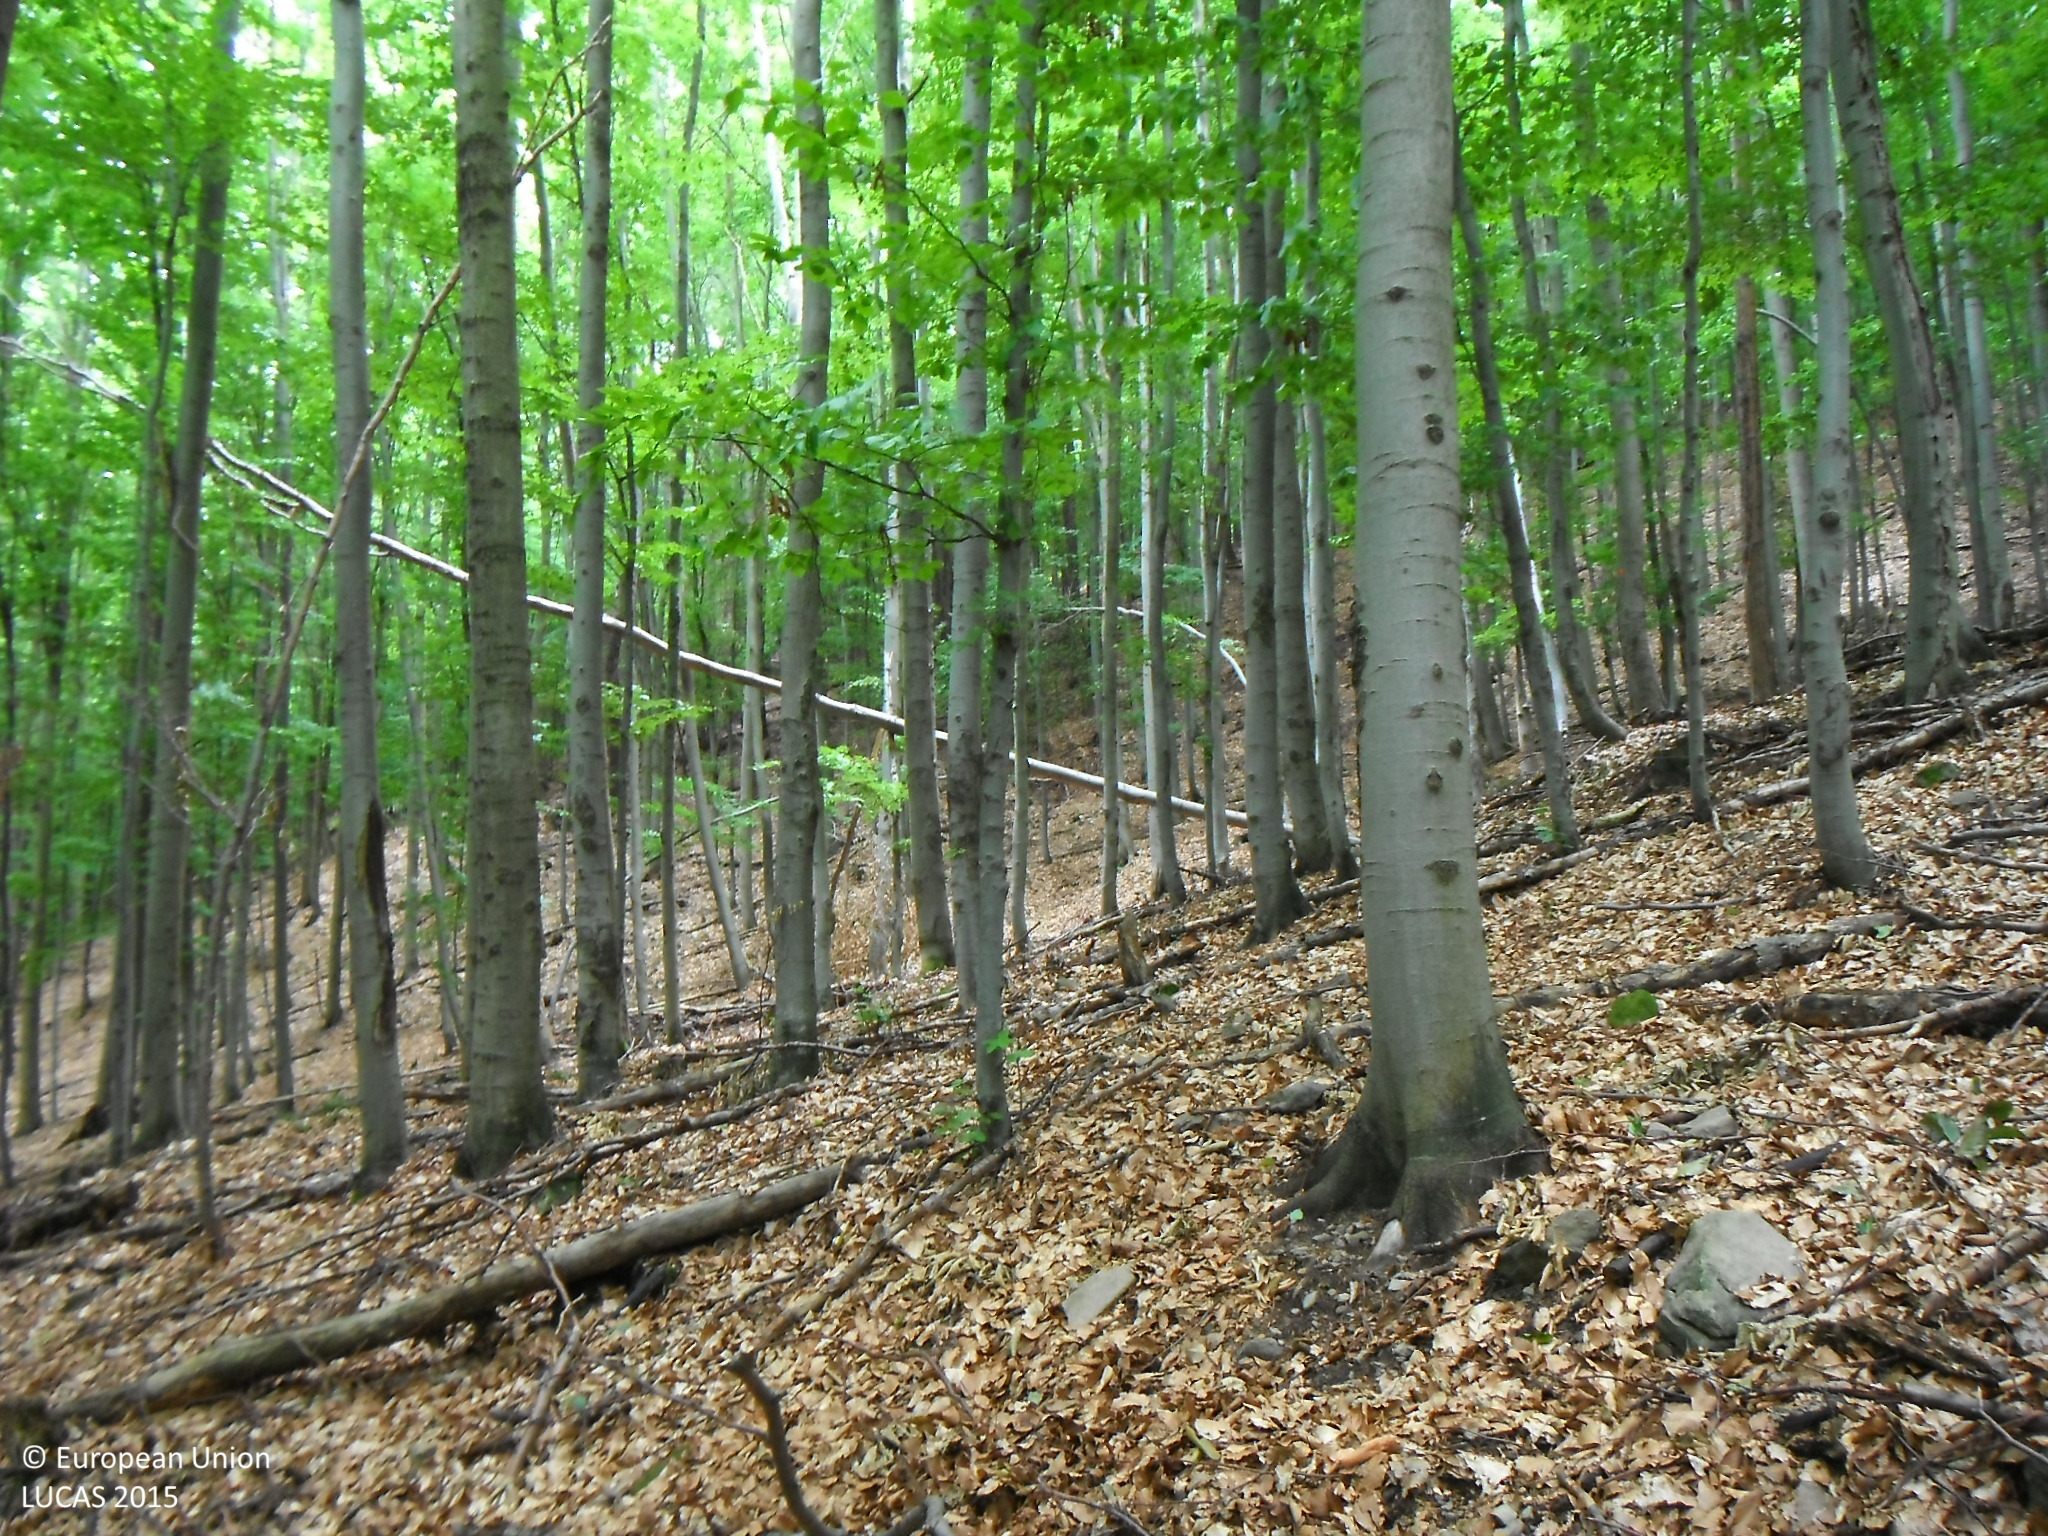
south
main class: Woodland
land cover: Broadleaved woodland
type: beech forest
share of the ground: > 75 %
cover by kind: broadleaved forest trees 100 %
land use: Forestry
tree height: > 5 m
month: July
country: SK
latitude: 48.5880
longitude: 21.4482
